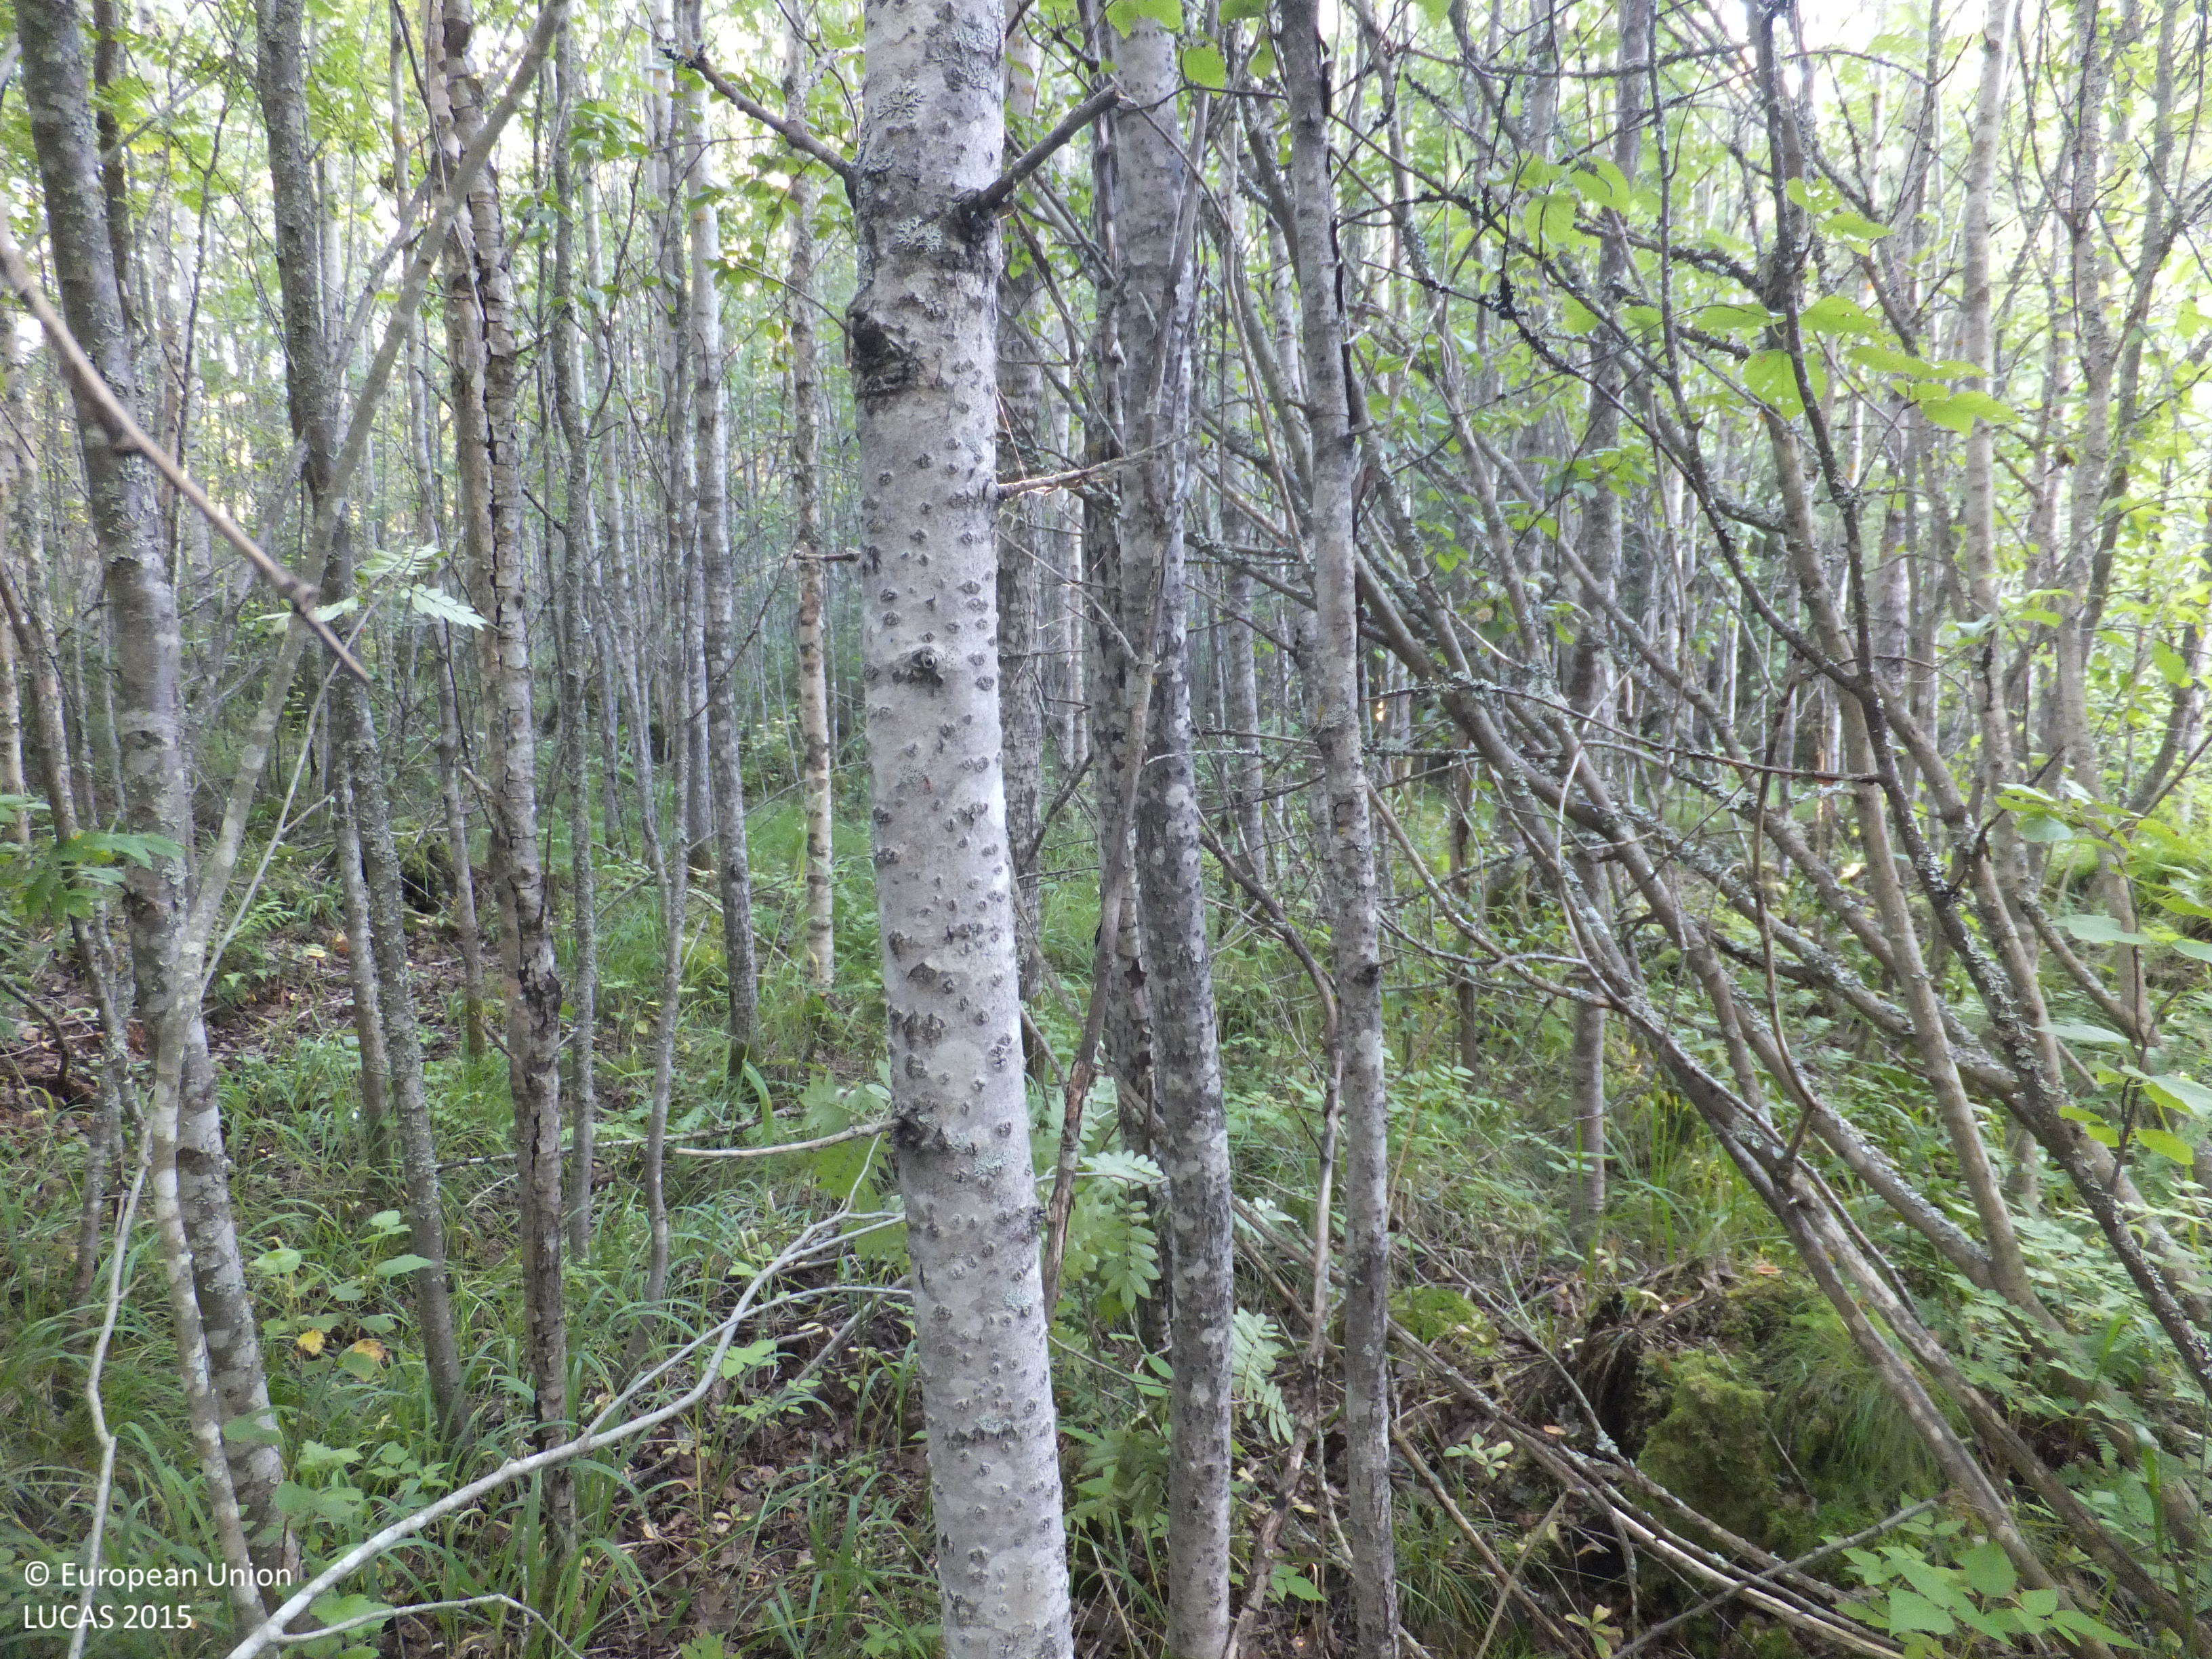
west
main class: Woodland
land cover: Broadleaved woodland
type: boreal forest
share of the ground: > 75 %
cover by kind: broadleaved forest trees 85 %, herbaceous plants 10 %, lichens and mosses 5 %
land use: Forestry
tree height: > 5 m
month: August
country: FI
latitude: 63.1142
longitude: 22.7193
